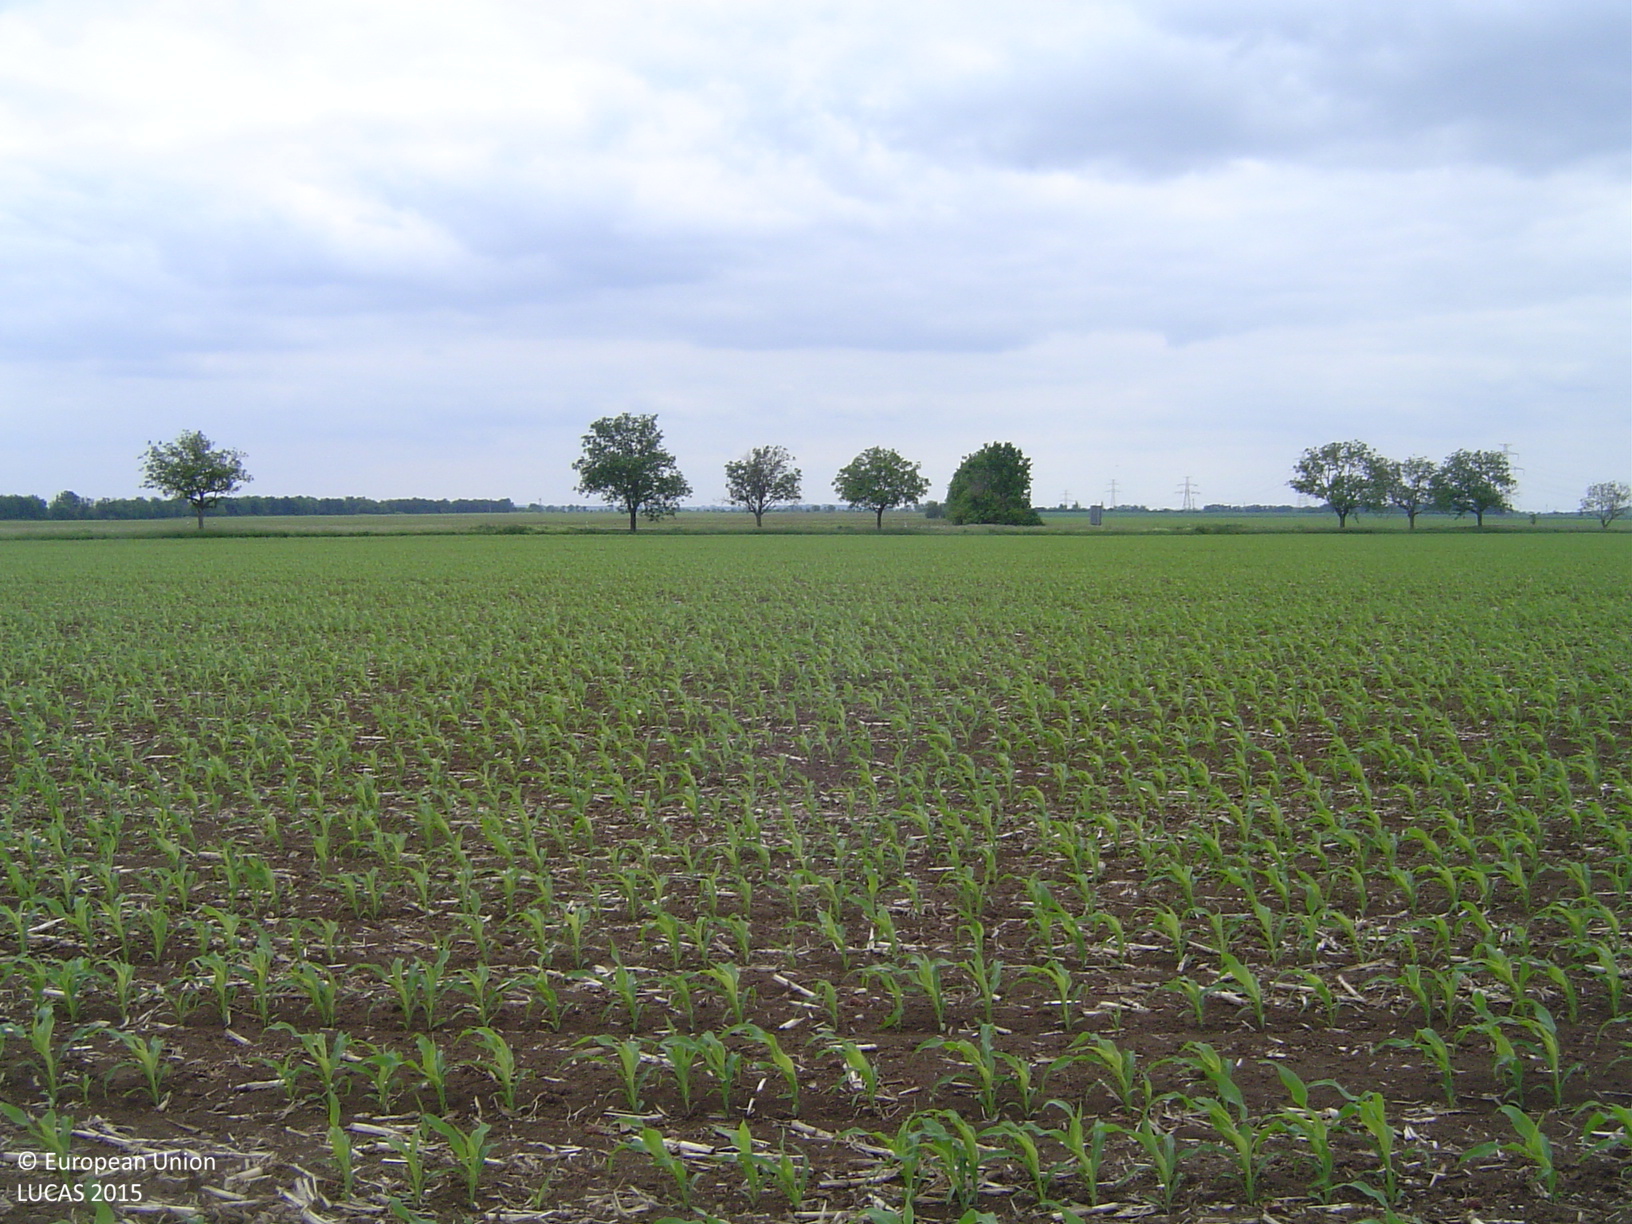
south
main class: Cropland
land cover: Maize
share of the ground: 25 - 50 %
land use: Agriculture (excluding fallow land and kitchen gardens)
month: May
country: CZ
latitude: 48.8636
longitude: 16.1531
